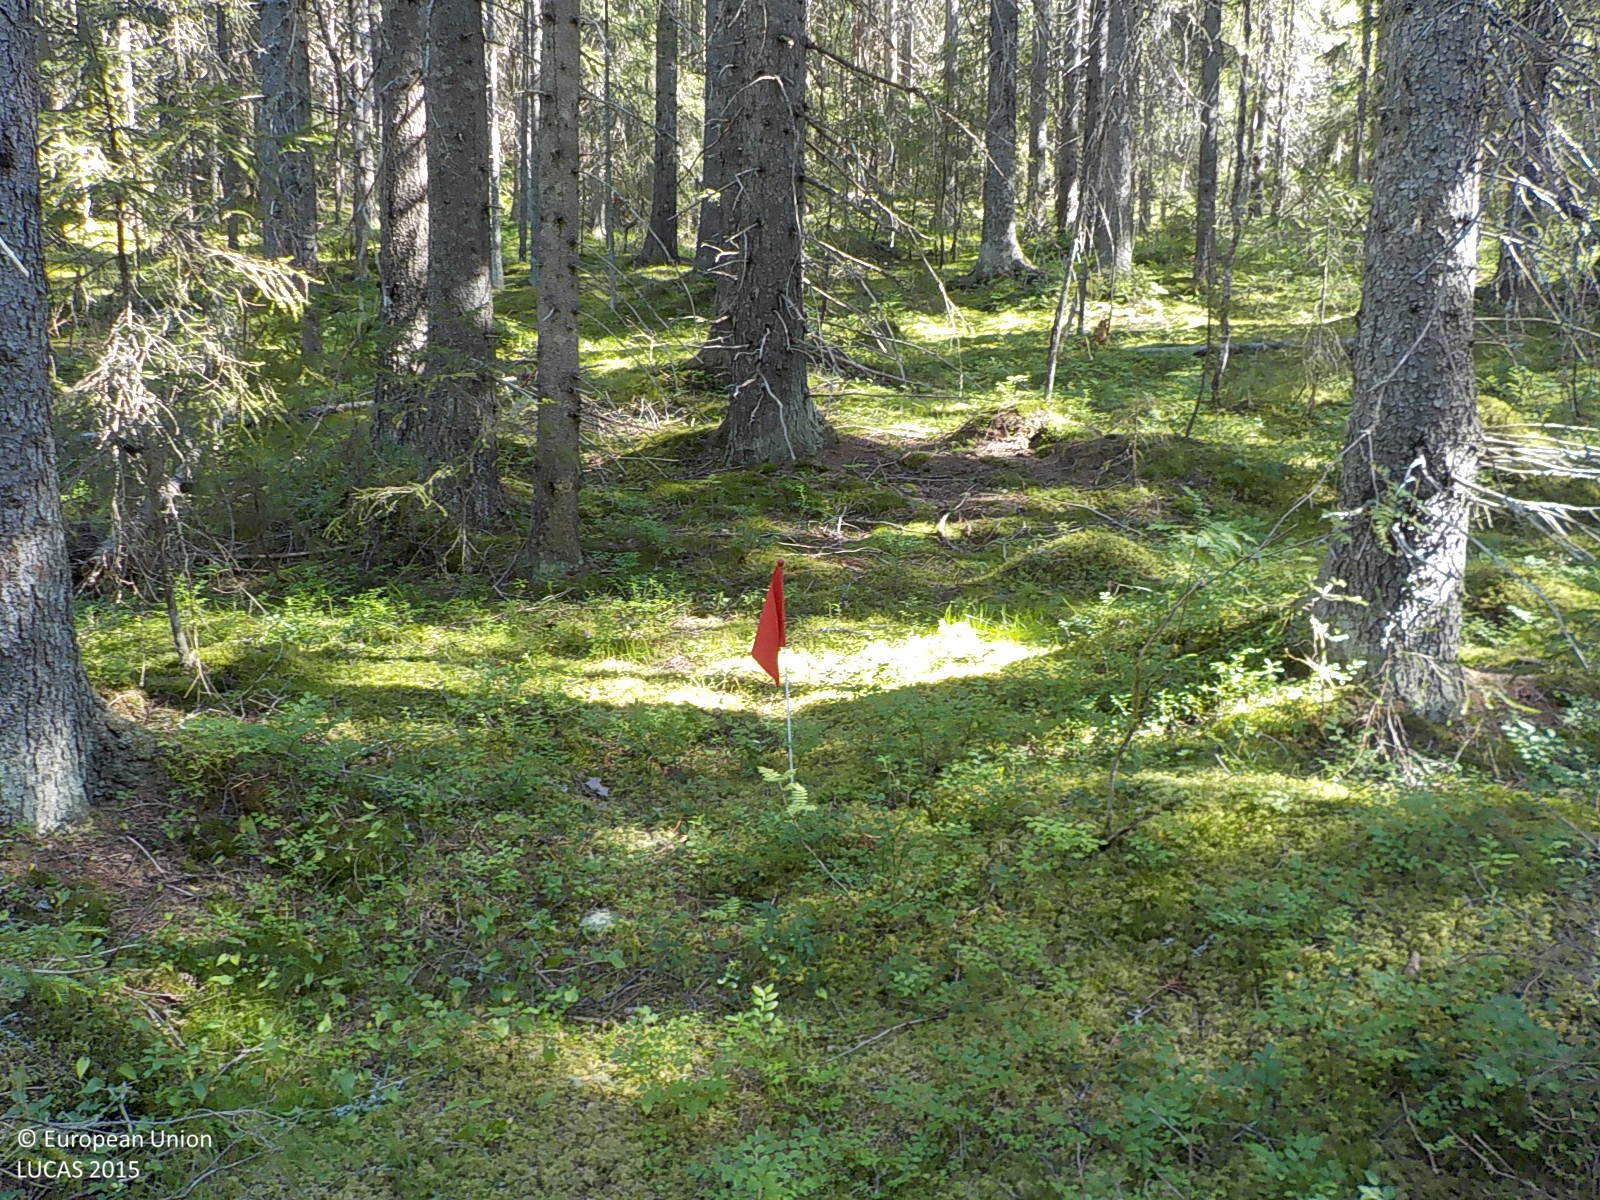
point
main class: Woodland
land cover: Spruce dominated coniferous woodland
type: boreal forest
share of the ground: > 75 %
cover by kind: coniferous forest trees 75 %, shrubs 15 %, lichens and mosses 10 %
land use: Forestry
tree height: > 5 m
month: August
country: SE
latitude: 63.3631
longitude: 18.6341
